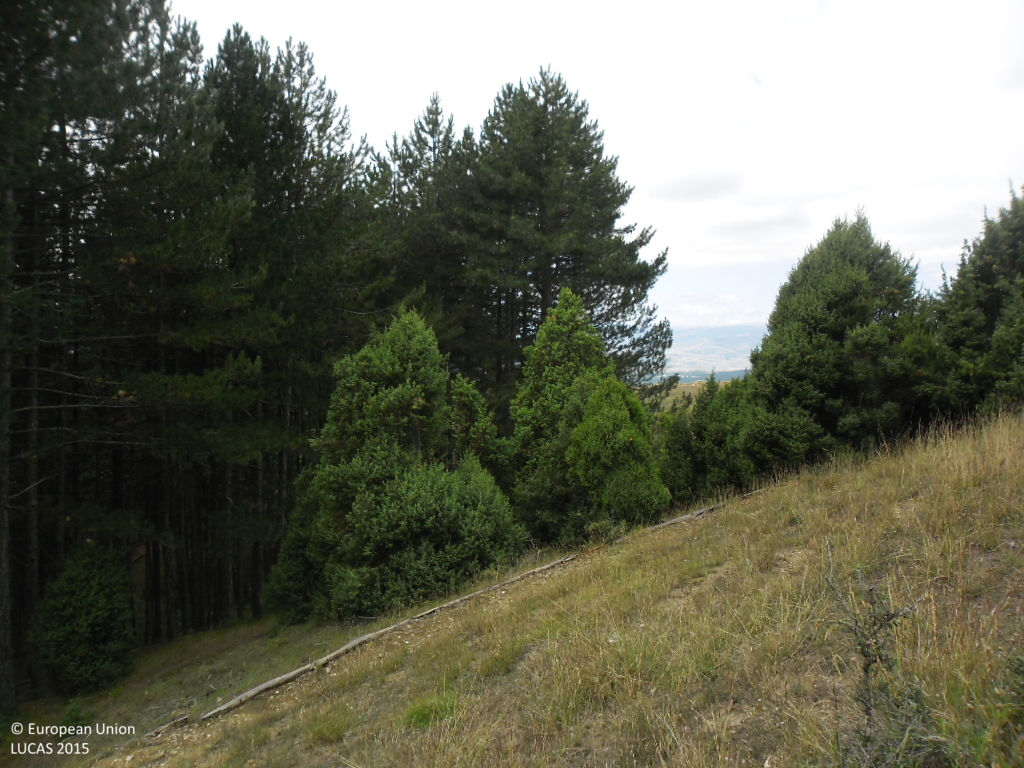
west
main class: Grassland
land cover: Grassland with sparse tree/shrub cover
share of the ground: > 75 %
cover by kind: herbaceous plants 90 %, broadleaved forest trees 5 %, shrubs 5 %
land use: Agriculture (excluding fallow land and kitchen gardens)
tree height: < 5 m
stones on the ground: < 10 %
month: September
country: BG
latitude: 42.0264
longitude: 23.1782
